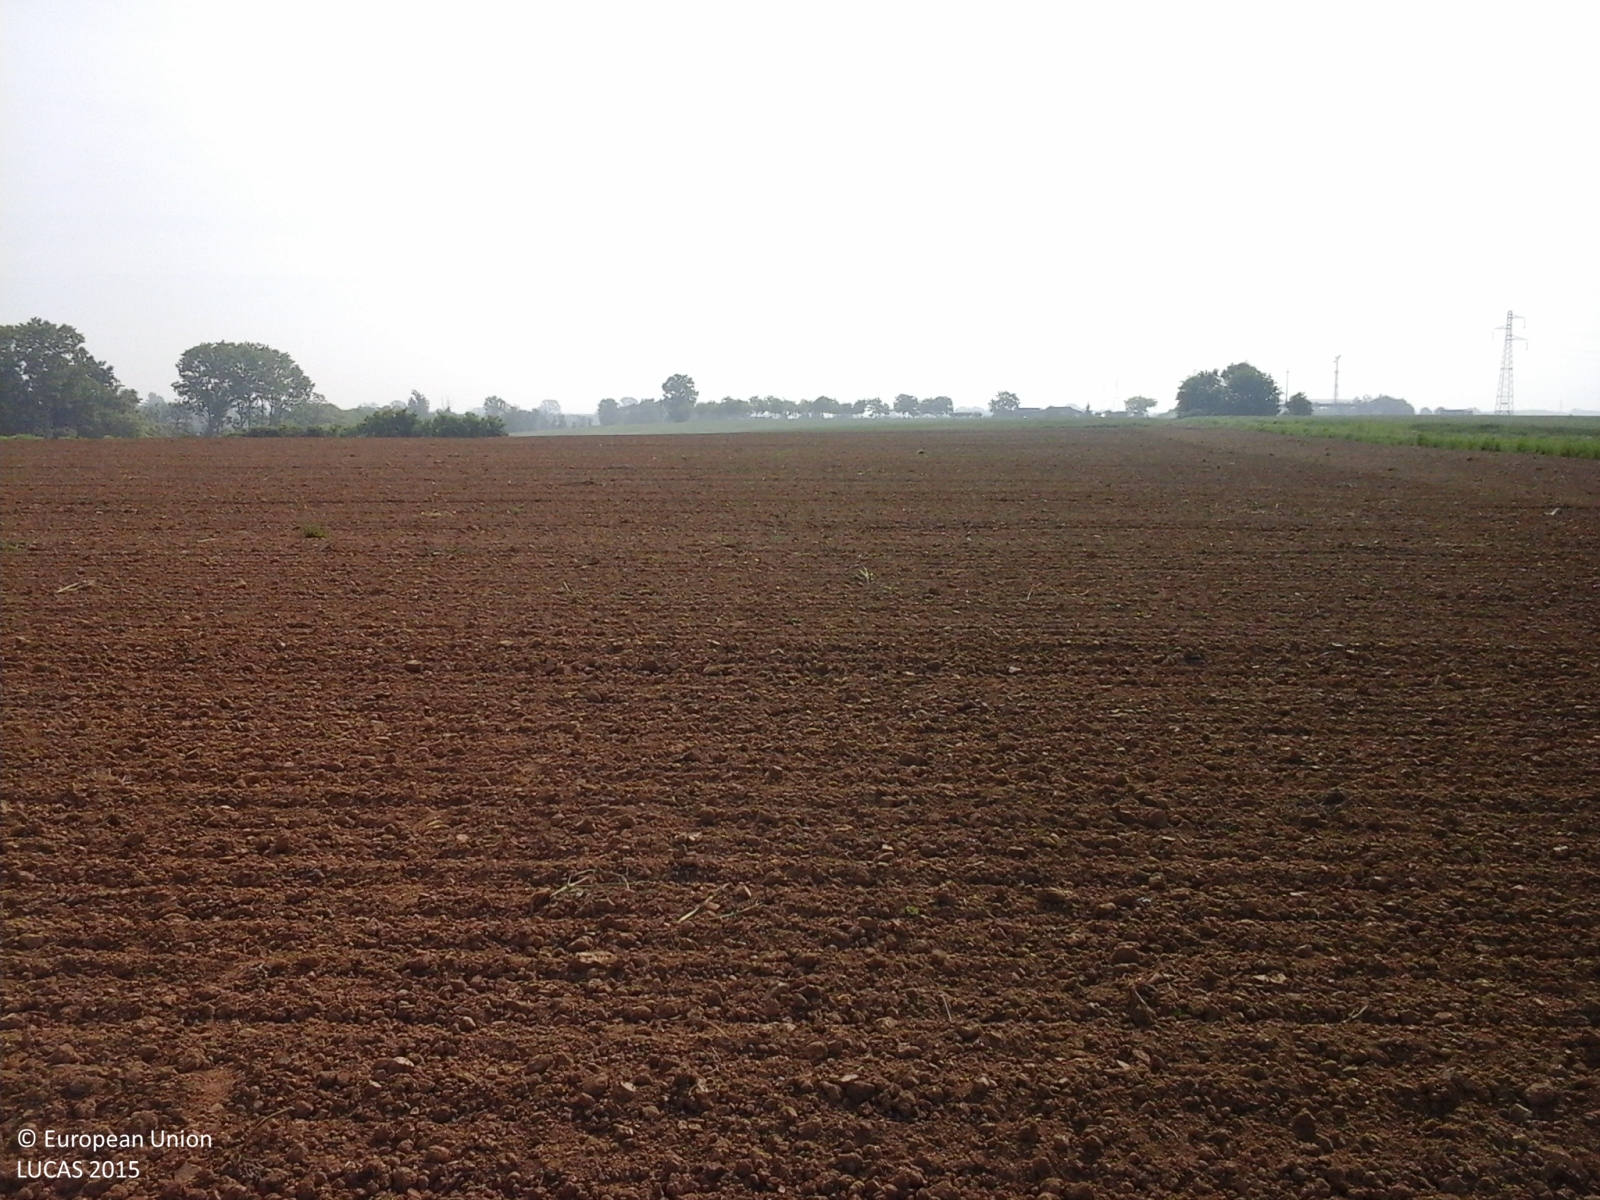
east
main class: Cropland
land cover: Other fibre and oleaginous crops
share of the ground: < 10 %
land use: Agriculture (excluding fallow land and kitchen gardens)
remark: Tilled/Sowed
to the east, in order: Other fibre and oleaginous crops; Temporary grasslands
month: May
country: IT
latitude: 44.9157
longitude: 8.4196
